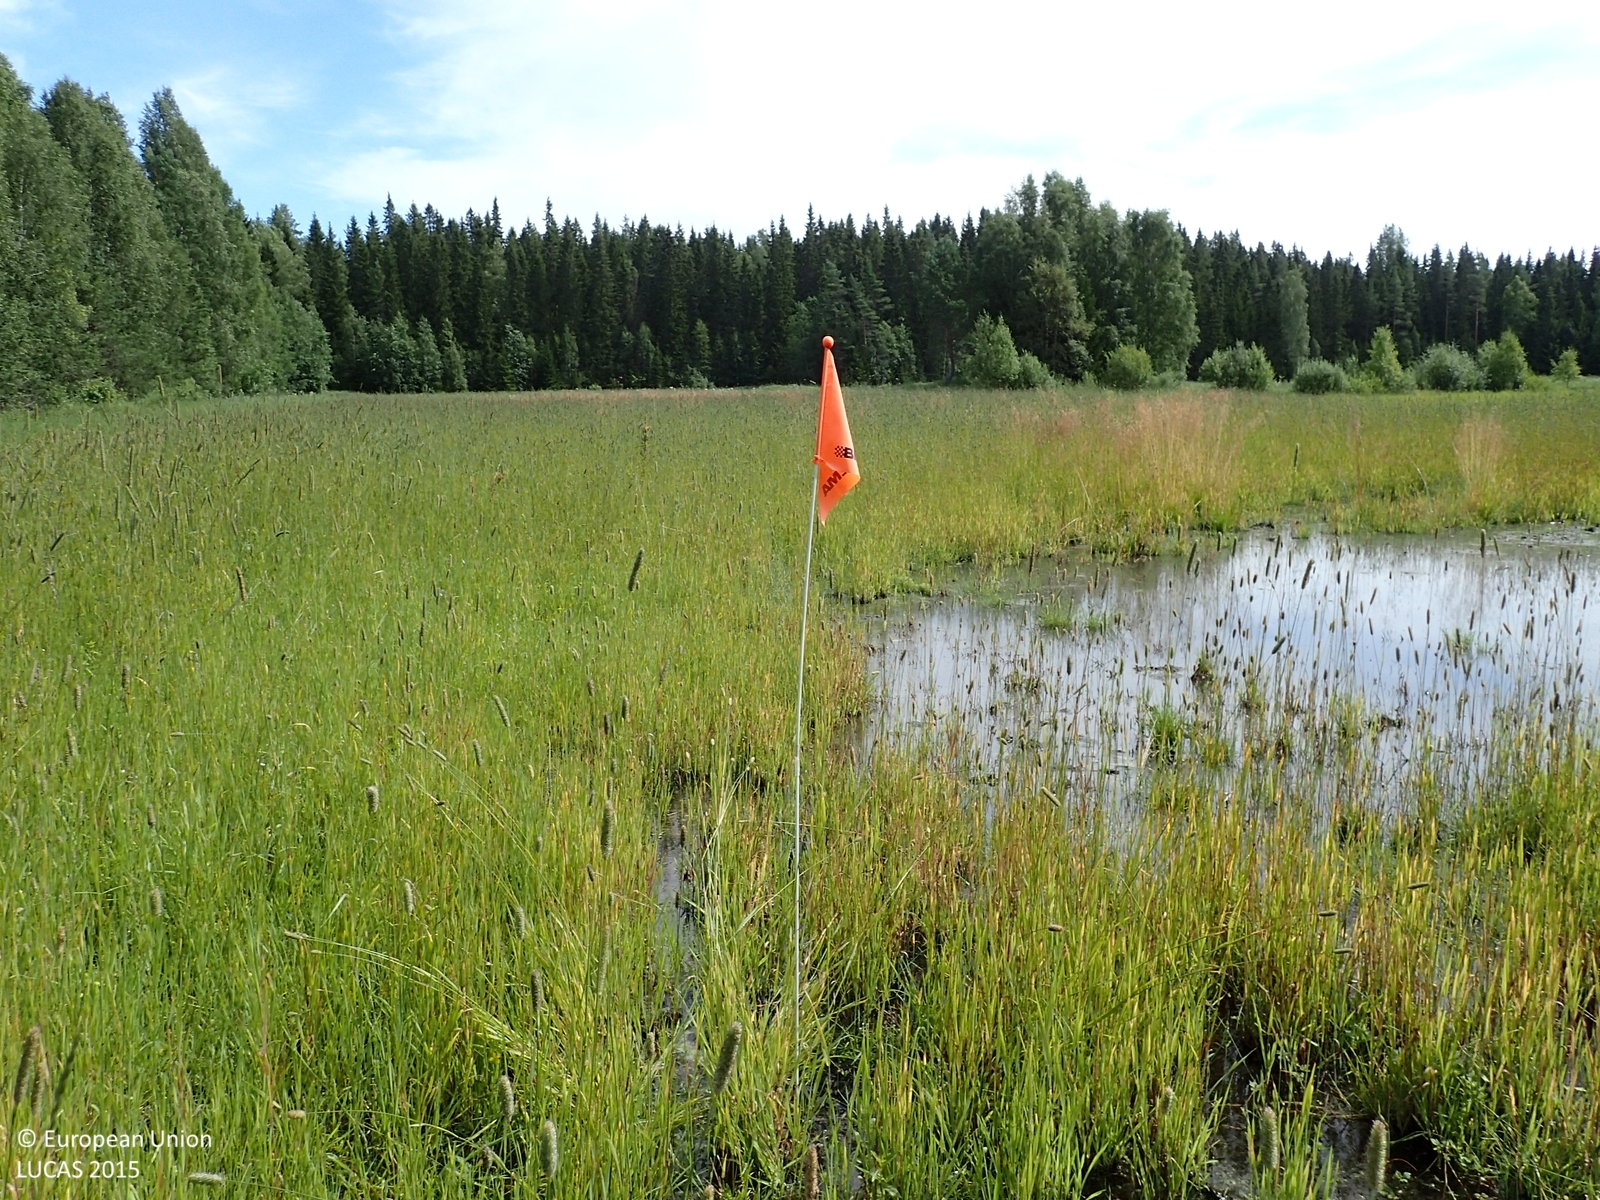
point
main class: Grassland
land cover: Spontaneously vegetated surfaces
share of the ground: > 75 %
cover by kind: herbaceous plants 100 %
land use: Fallow land
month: August
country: FI
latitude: 62.8374
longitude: 21.8451
